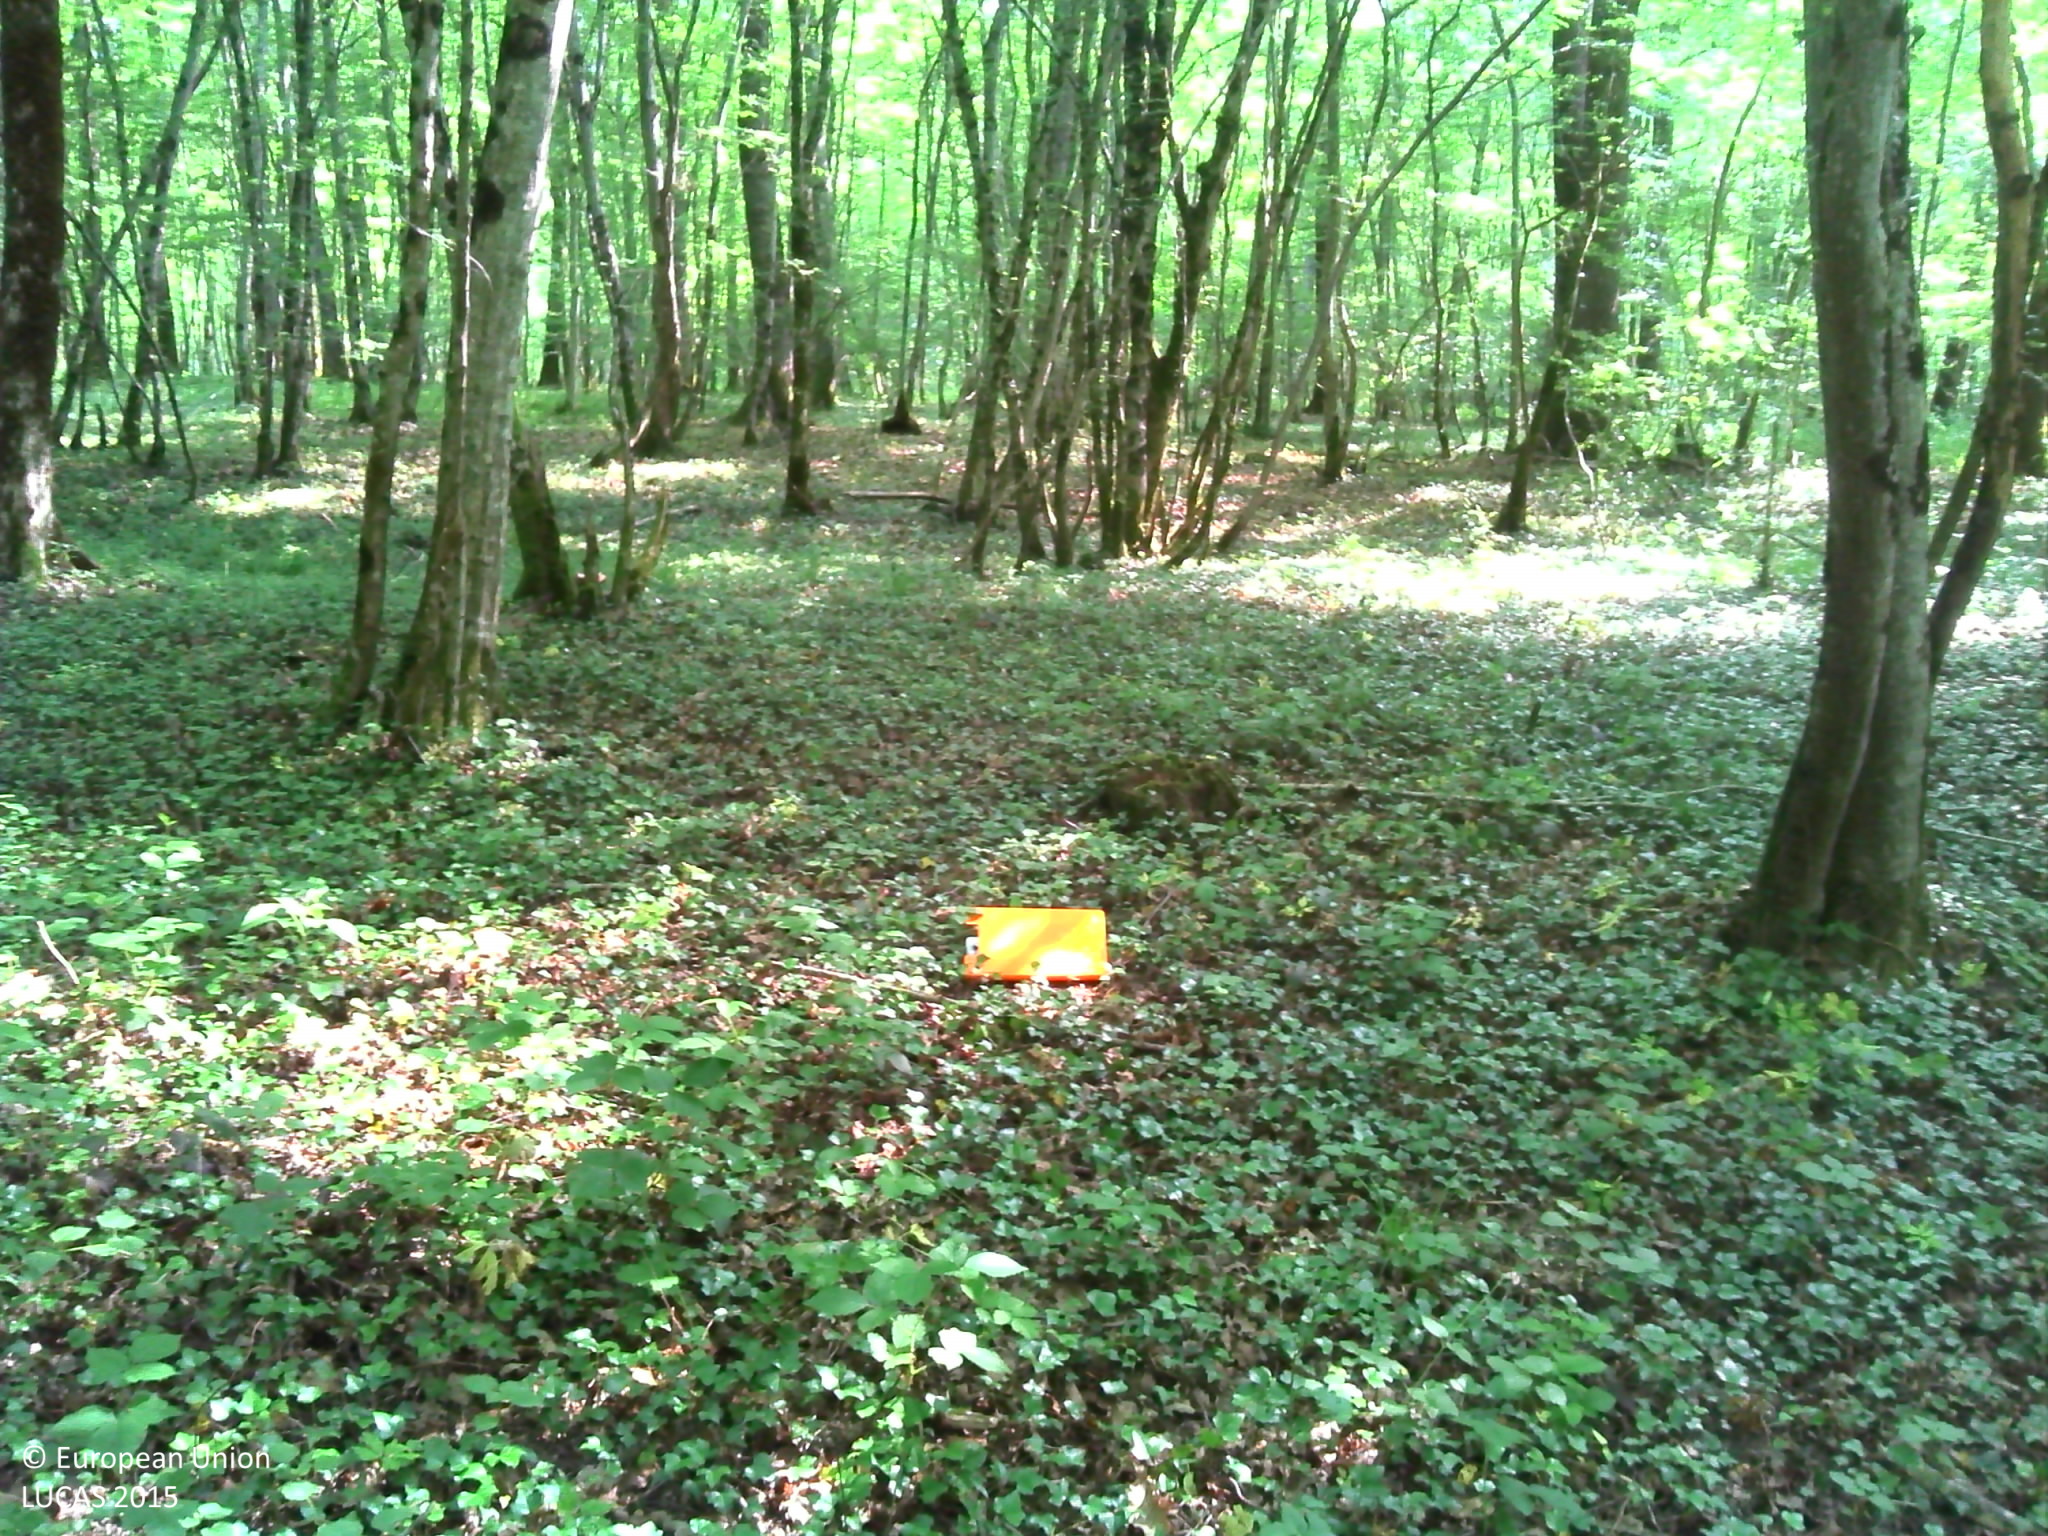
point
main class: Woodland
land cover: Broadleaved woodland
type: beech forest
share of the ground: > 75 %
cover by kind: broadleaved forest trees 95 %, herbaceous plants 5 %
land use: Forestry
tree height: > 5 m
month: June
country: FR
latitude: 47.8676
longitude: 6.1374
